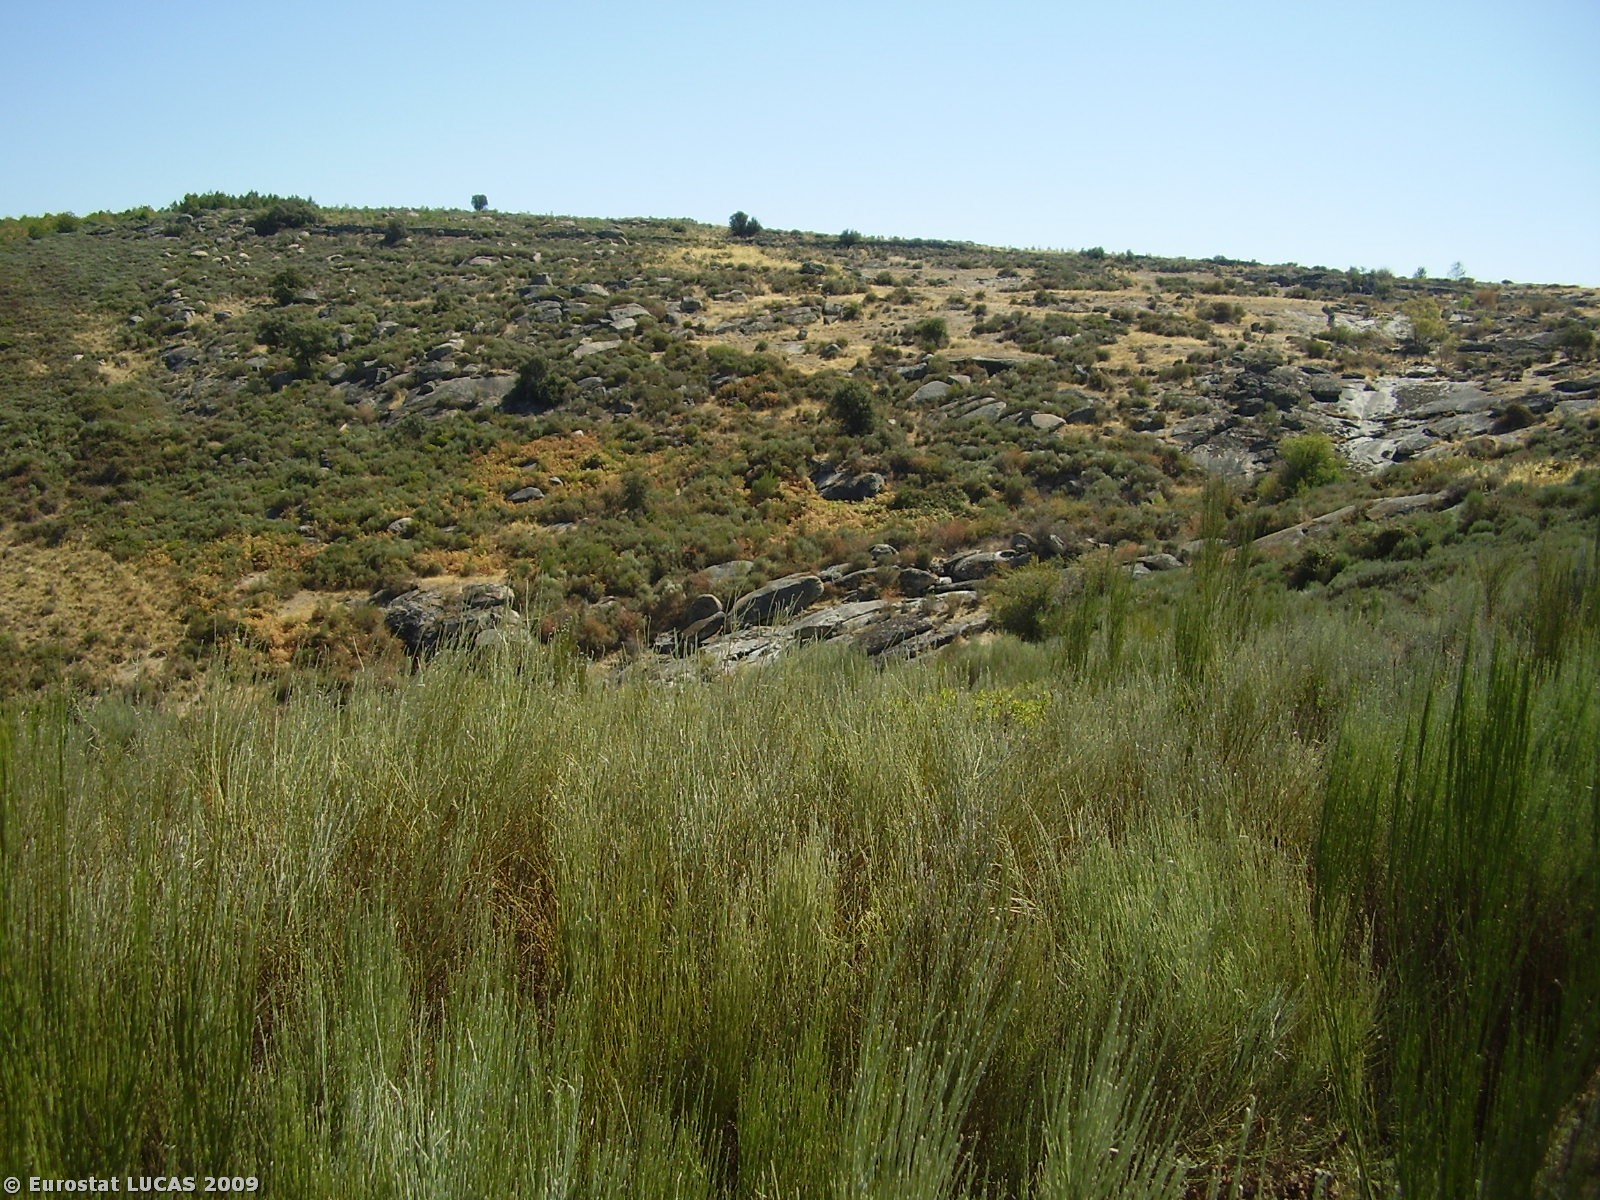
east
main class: Shrubland
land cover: Shrubland without tree cover
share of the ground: > 75 %
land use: Fallow land
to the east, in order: Shrubland without tree cover; Rivers and streams; Shrubland with sparse tree cover
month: August
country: PT
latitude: 41.2296
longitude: -6.7467
